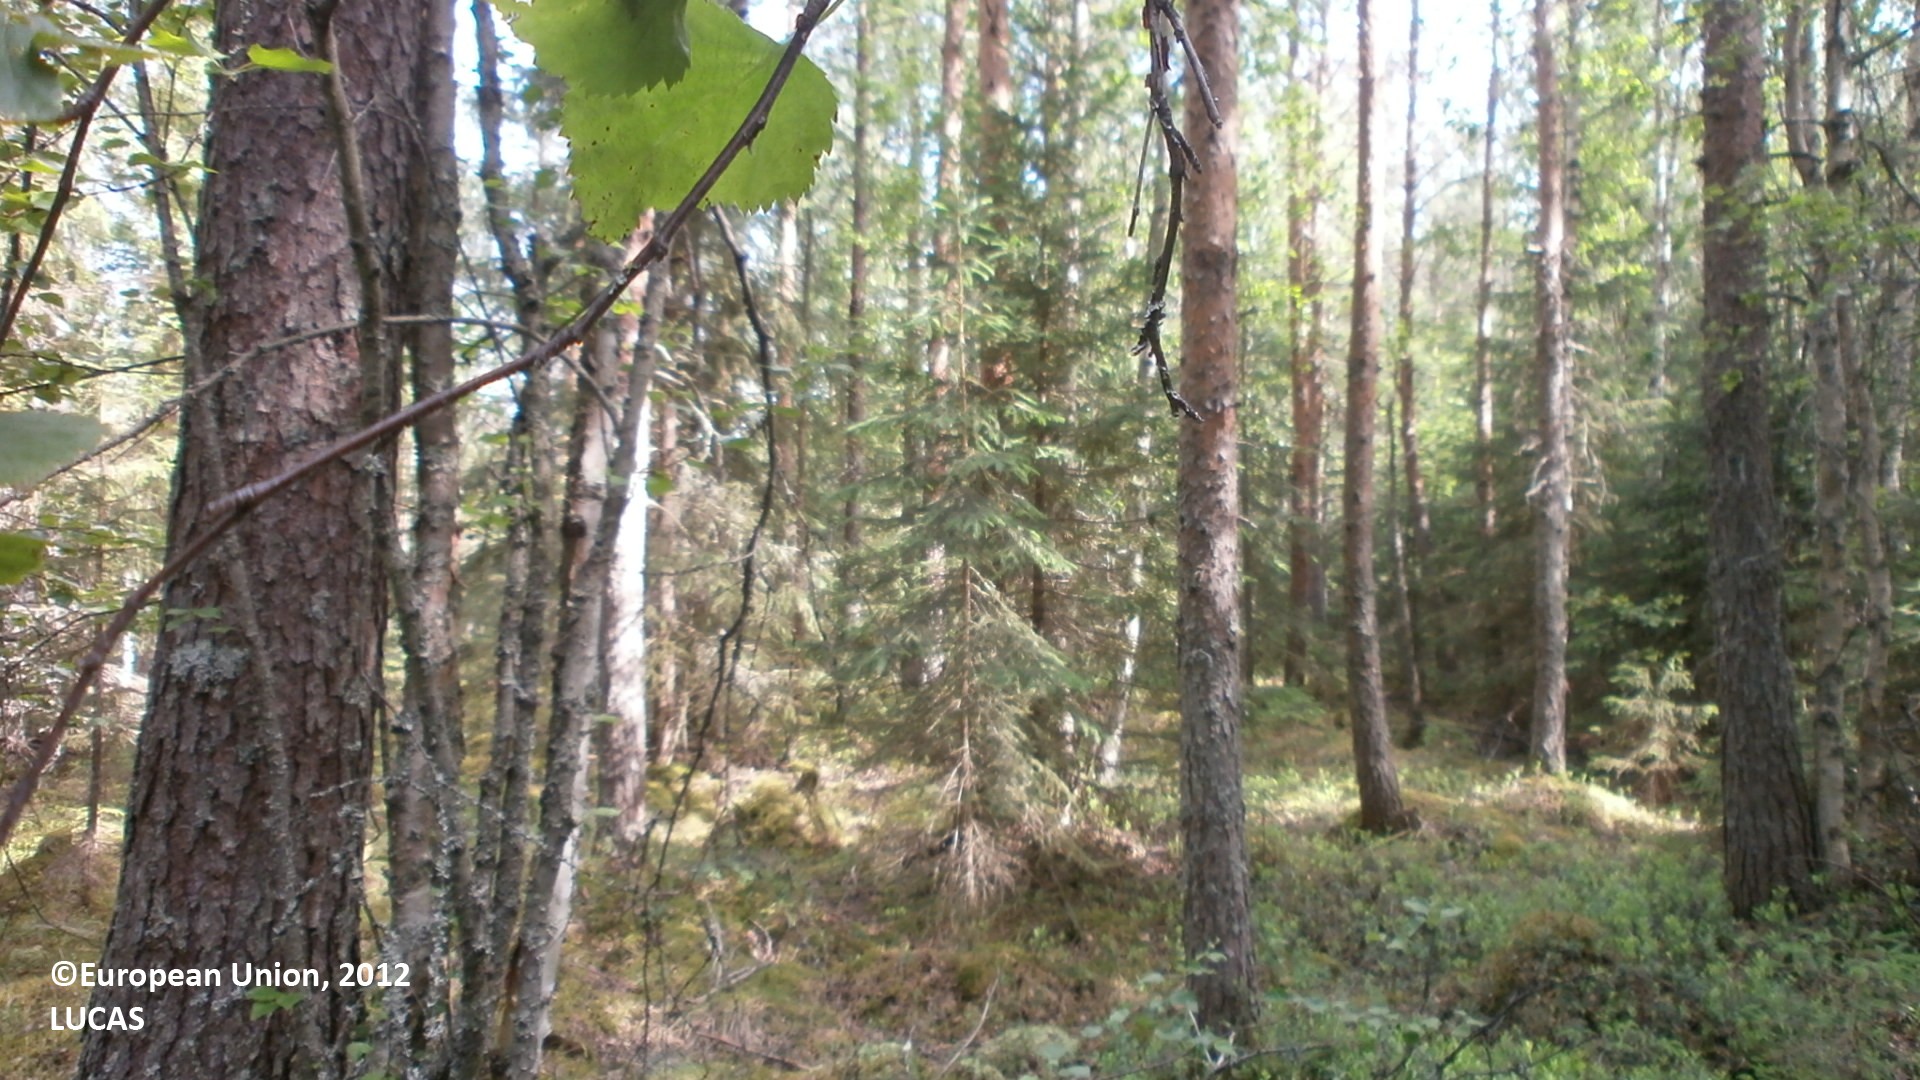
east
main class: Woodland
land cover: Pine dominated mixed woodland
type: boreal forest
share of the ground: > 75 %
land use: Forestry
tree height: > 5 m
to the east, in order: Pine dominated mixed woodland; Pine dominated coniferous woodland; Pine dominated mixed woodland; Broadleaved woodland; Spruce dominated coniferous woodland; Tracks; Spruce dominated coniferous woodland
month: July
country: FI
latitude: 64.0876
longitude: 24.7850
